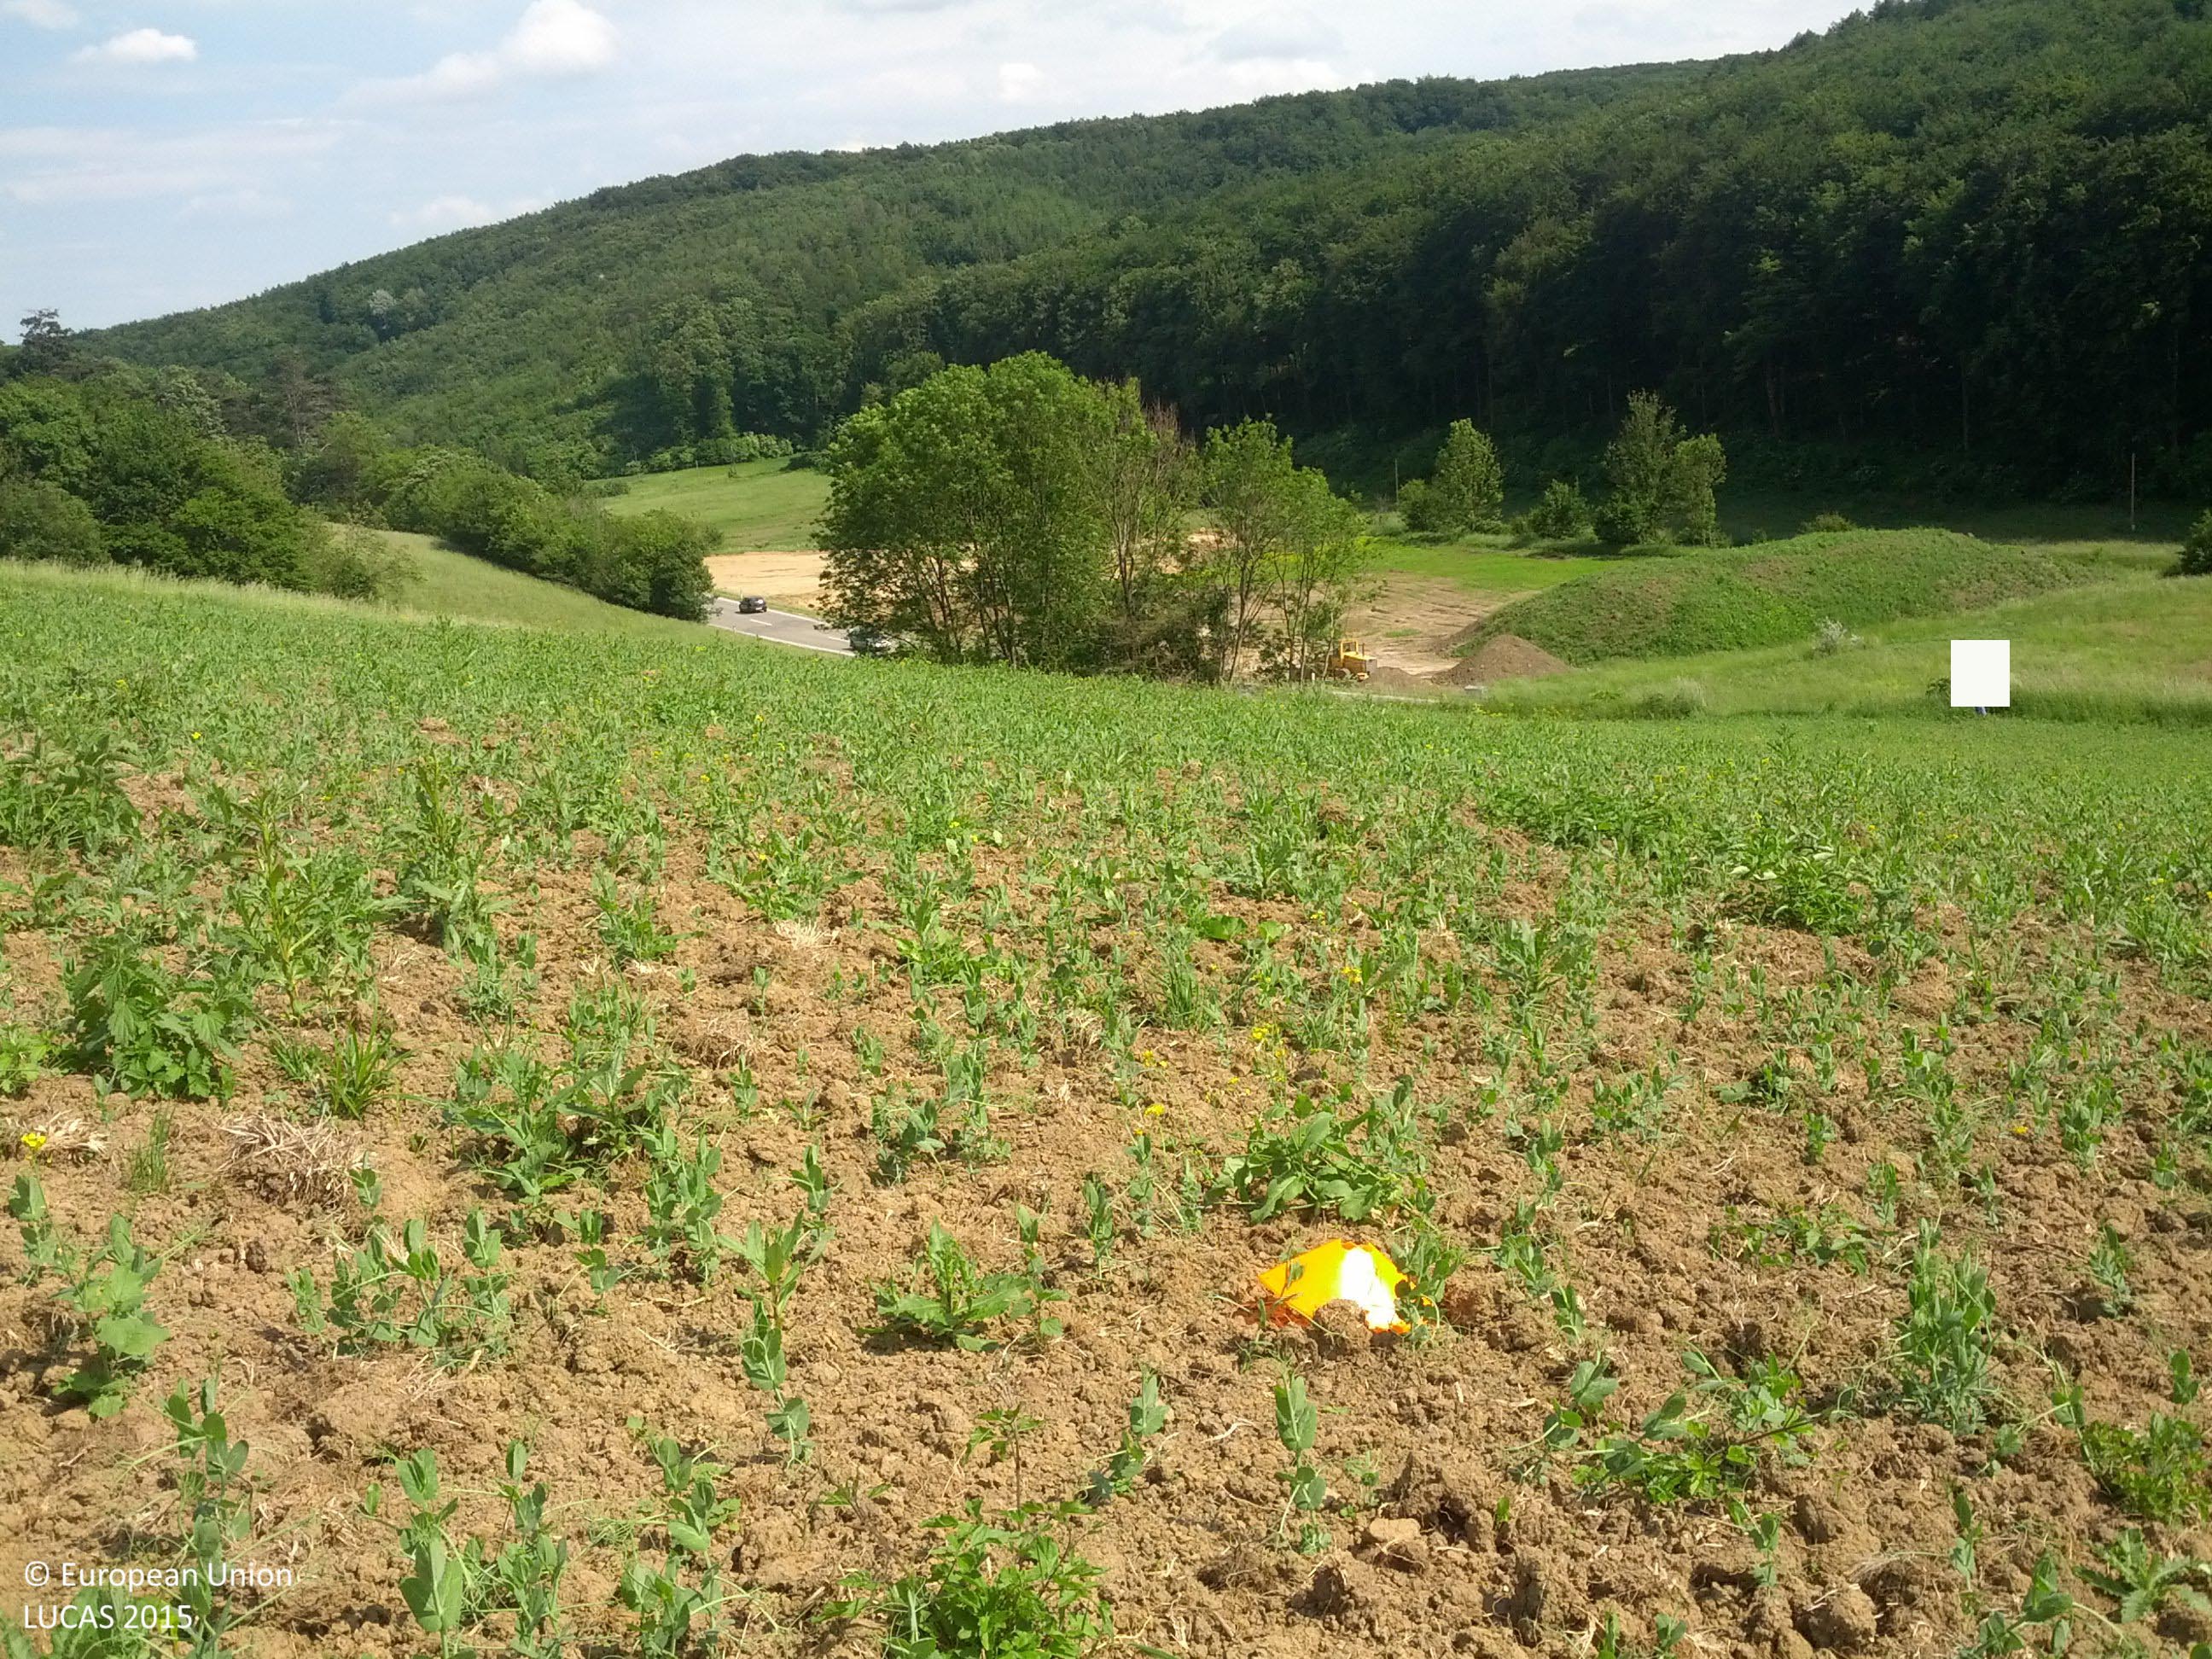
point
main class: Cropland
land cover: Dry pulses
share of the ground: 25 - 50 %
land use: Agriculture (excluding fallow land and kitchen gardens)
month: May
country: AT
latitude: 48.3185
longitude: 16.2216
